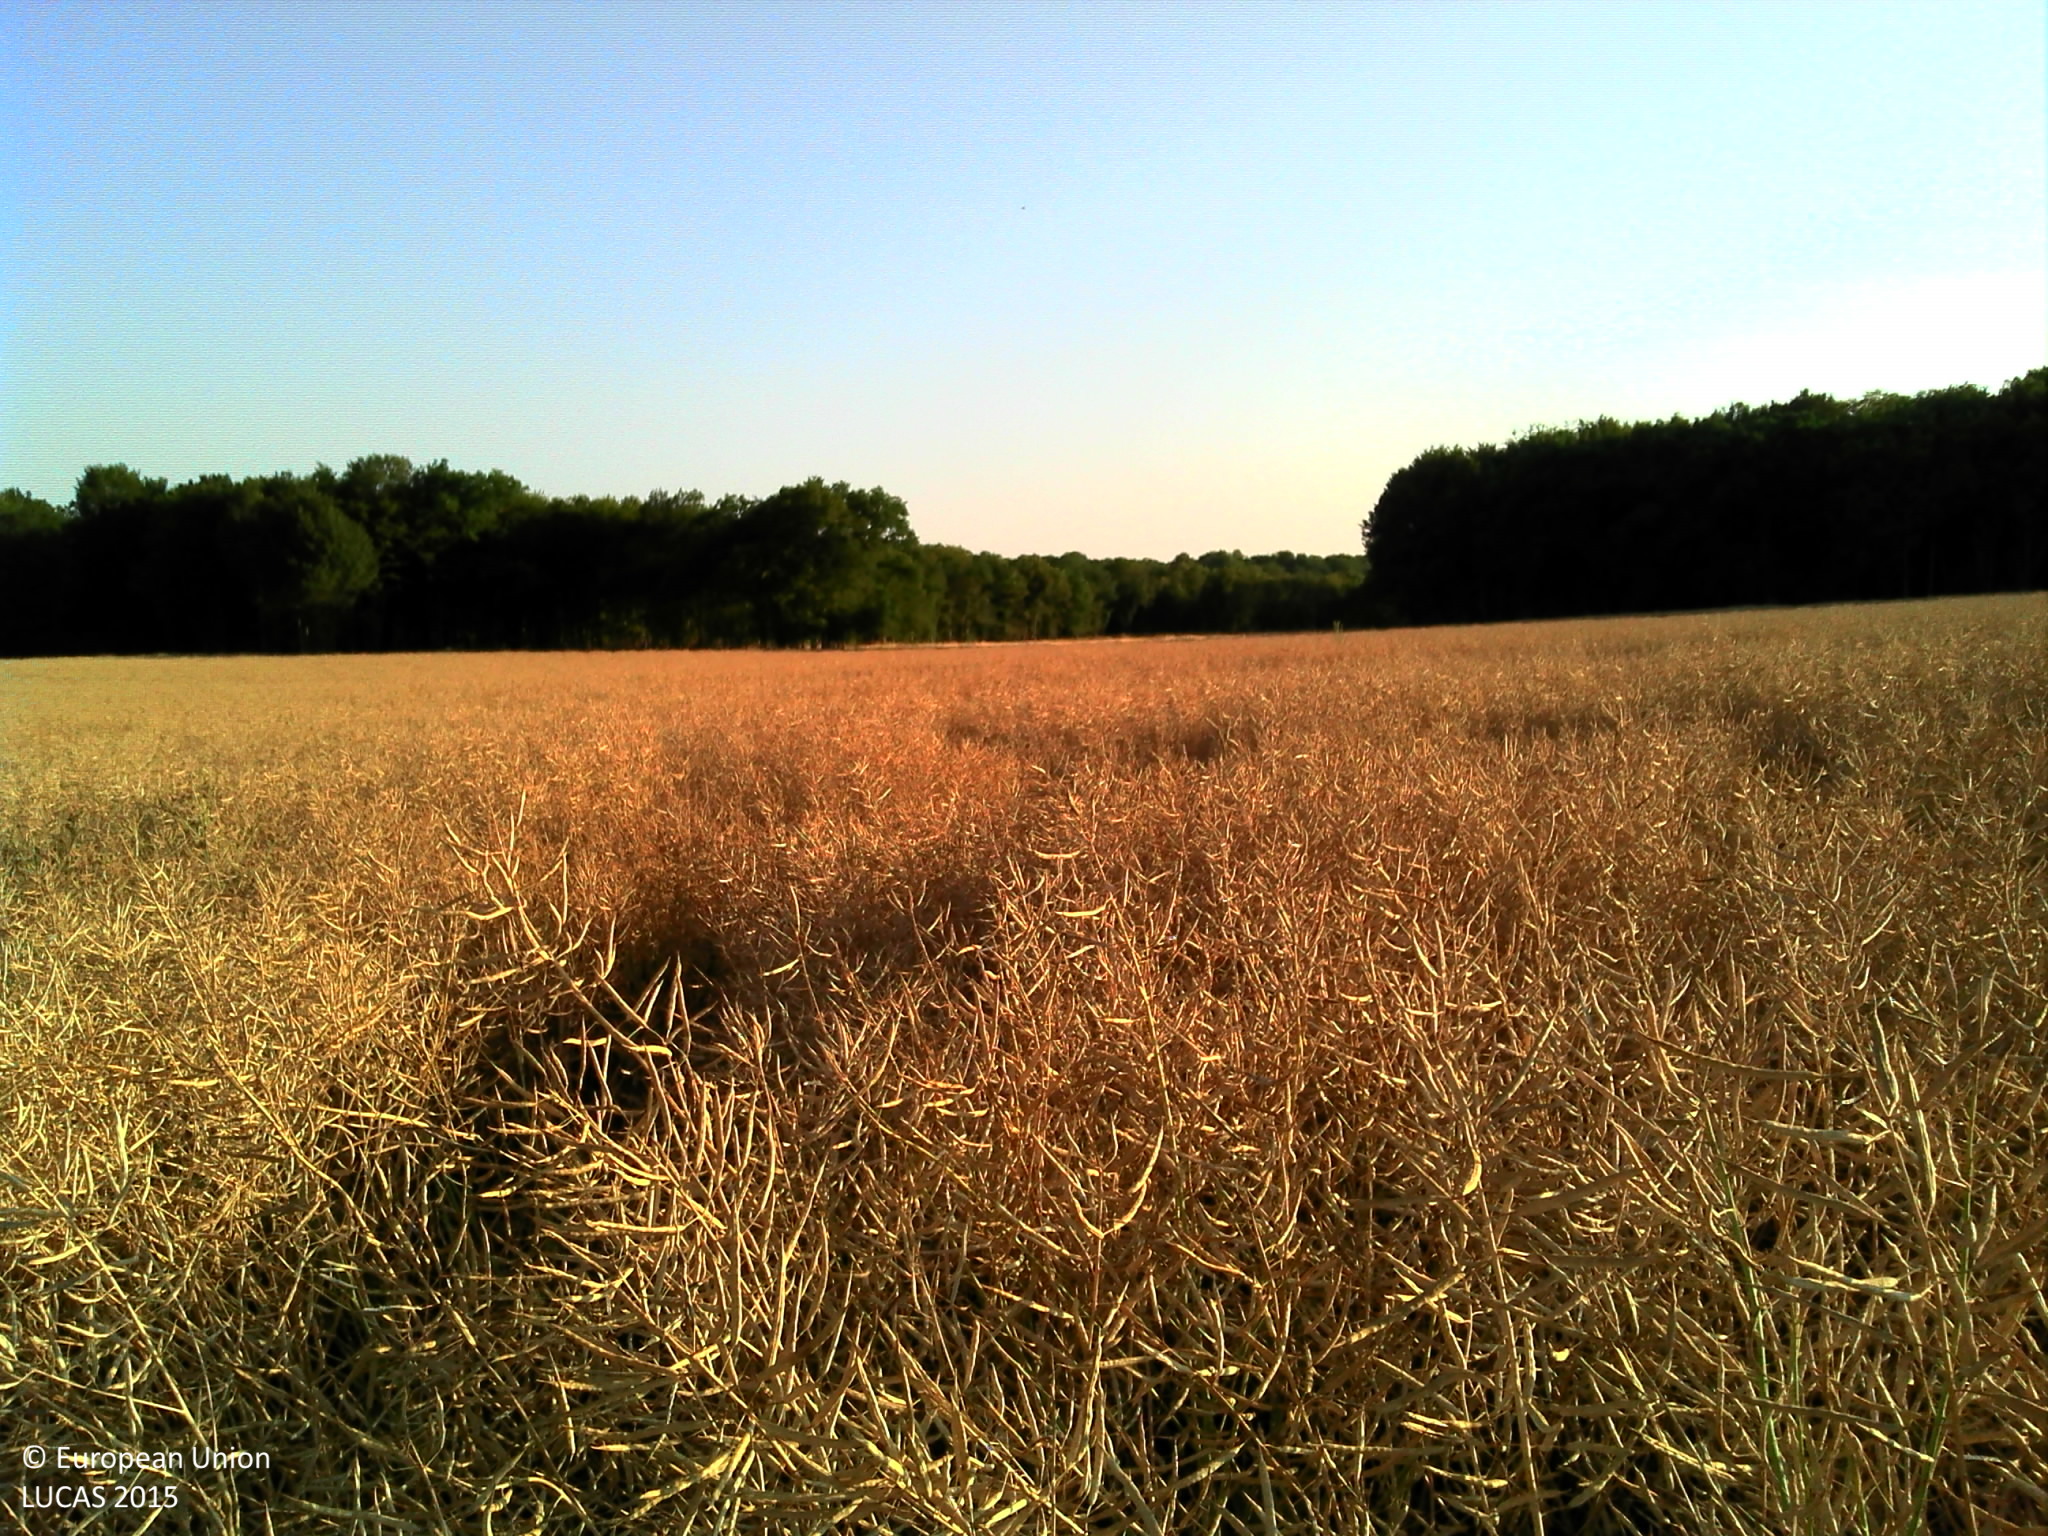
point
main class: Cropland
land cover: Rape and turnip rape
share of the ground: > 75 %
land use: Agriculture (excluding fallow land and kitchen gardens)
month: July
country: FR
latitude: 48.0366
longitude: 4.9695
